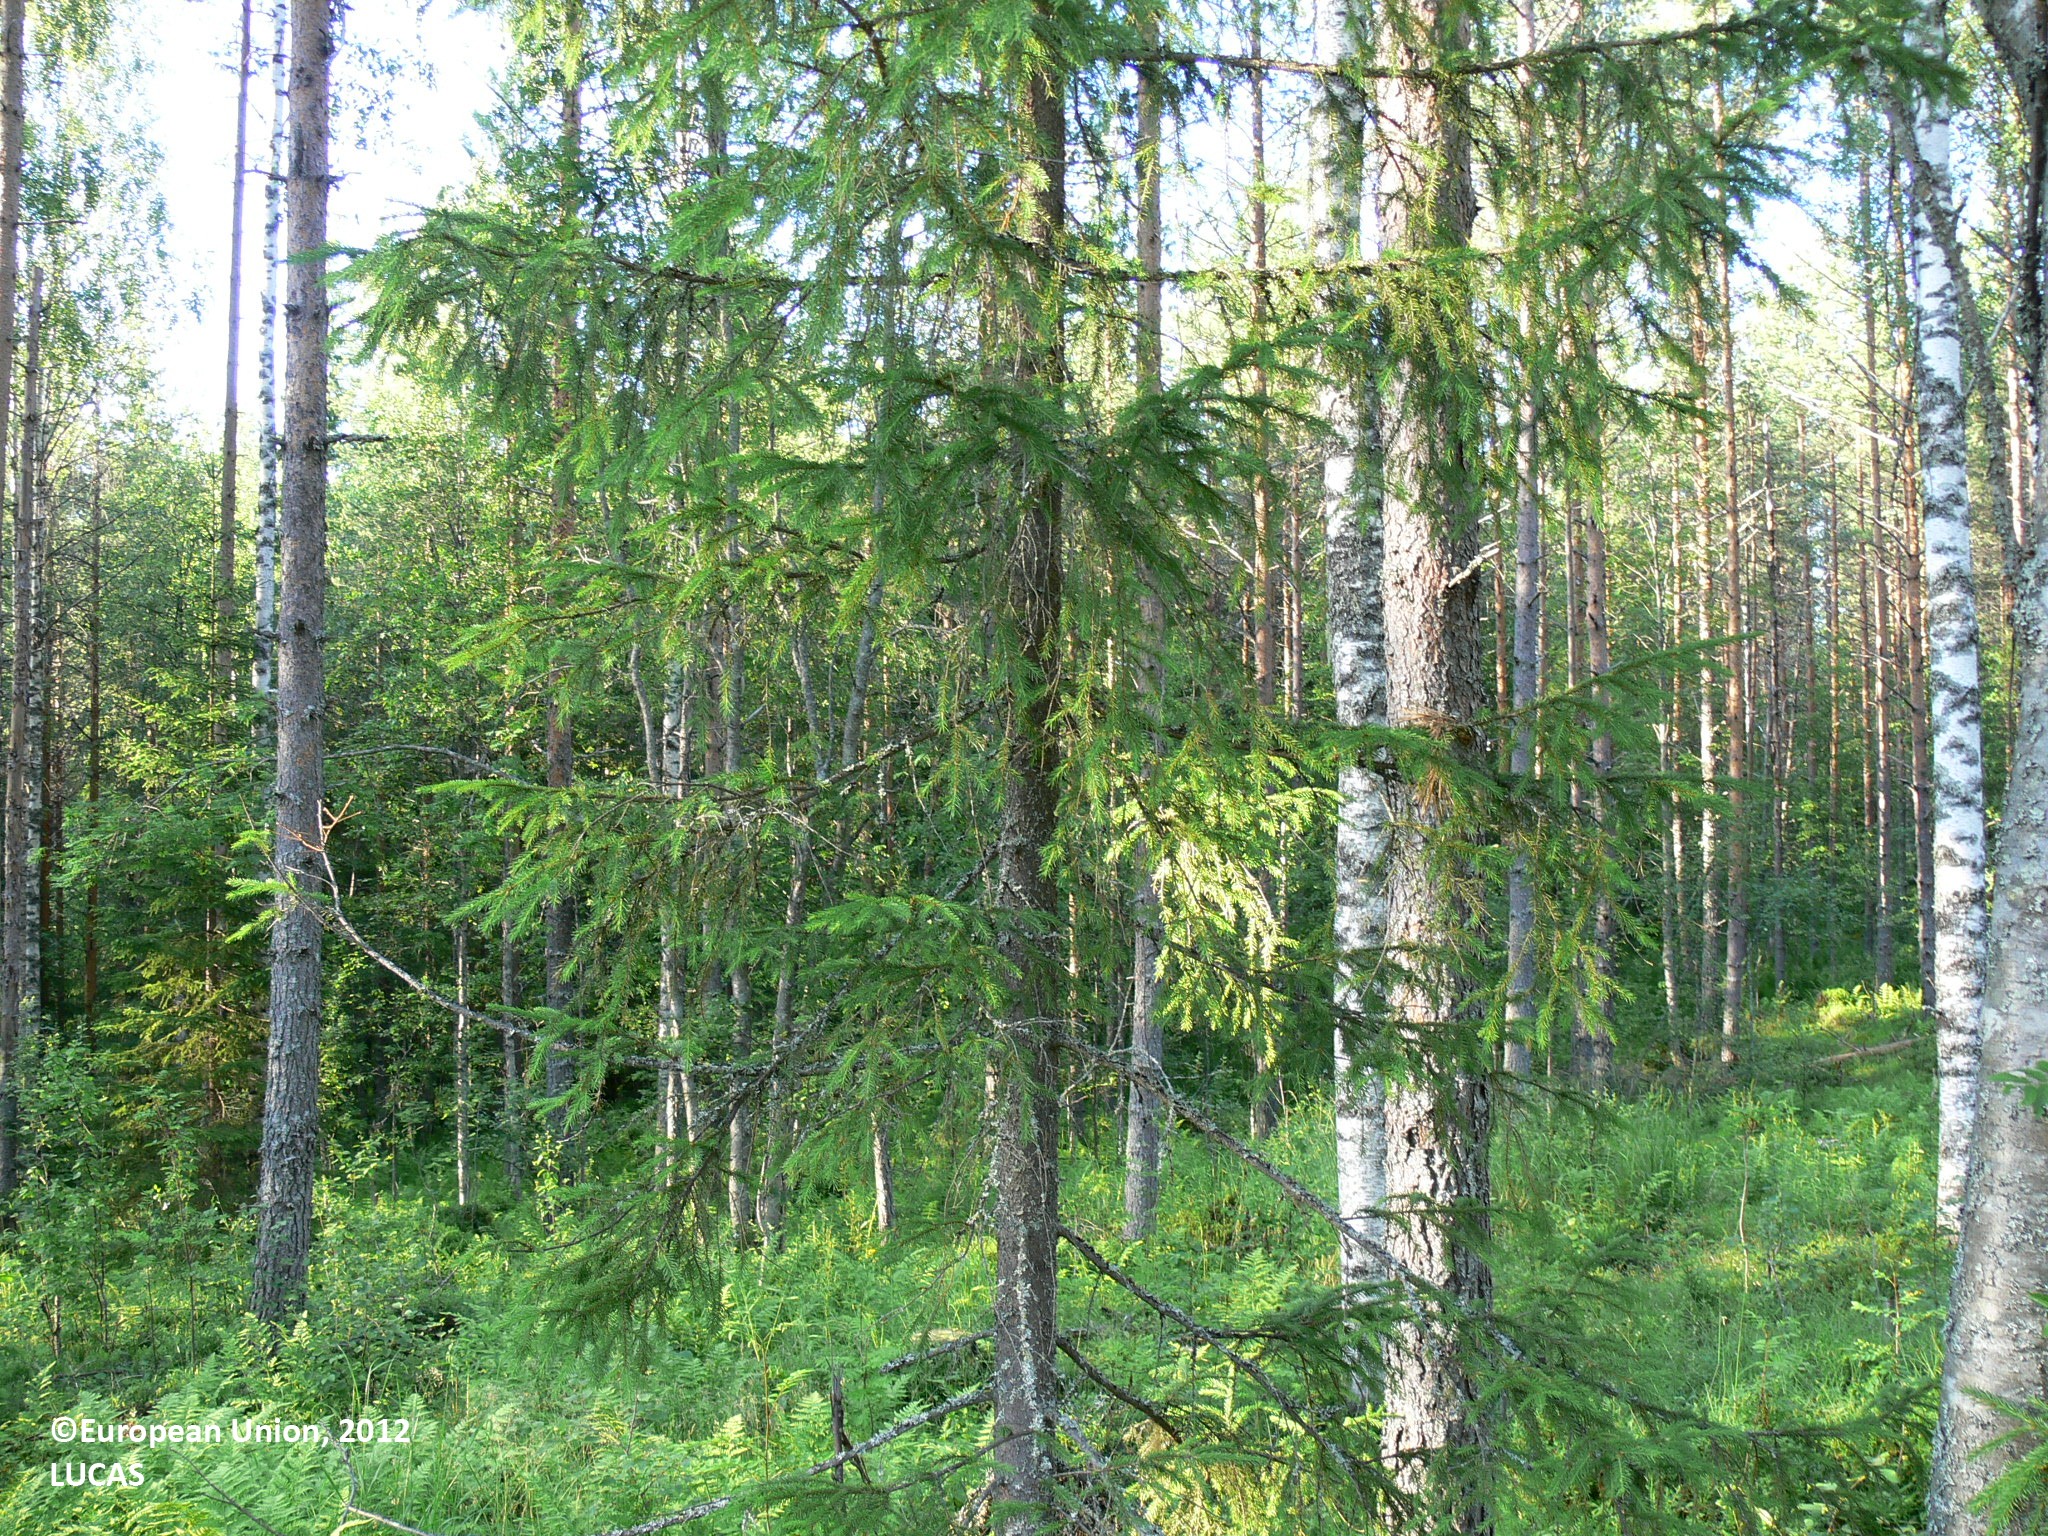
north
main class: Woodland
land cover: Pine dominated mixed woodland
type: boreal forest
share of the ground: > 75 %
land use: Forestry
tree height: > 5 m
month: July
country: FI
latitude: 63.2985
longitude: 30.8965
